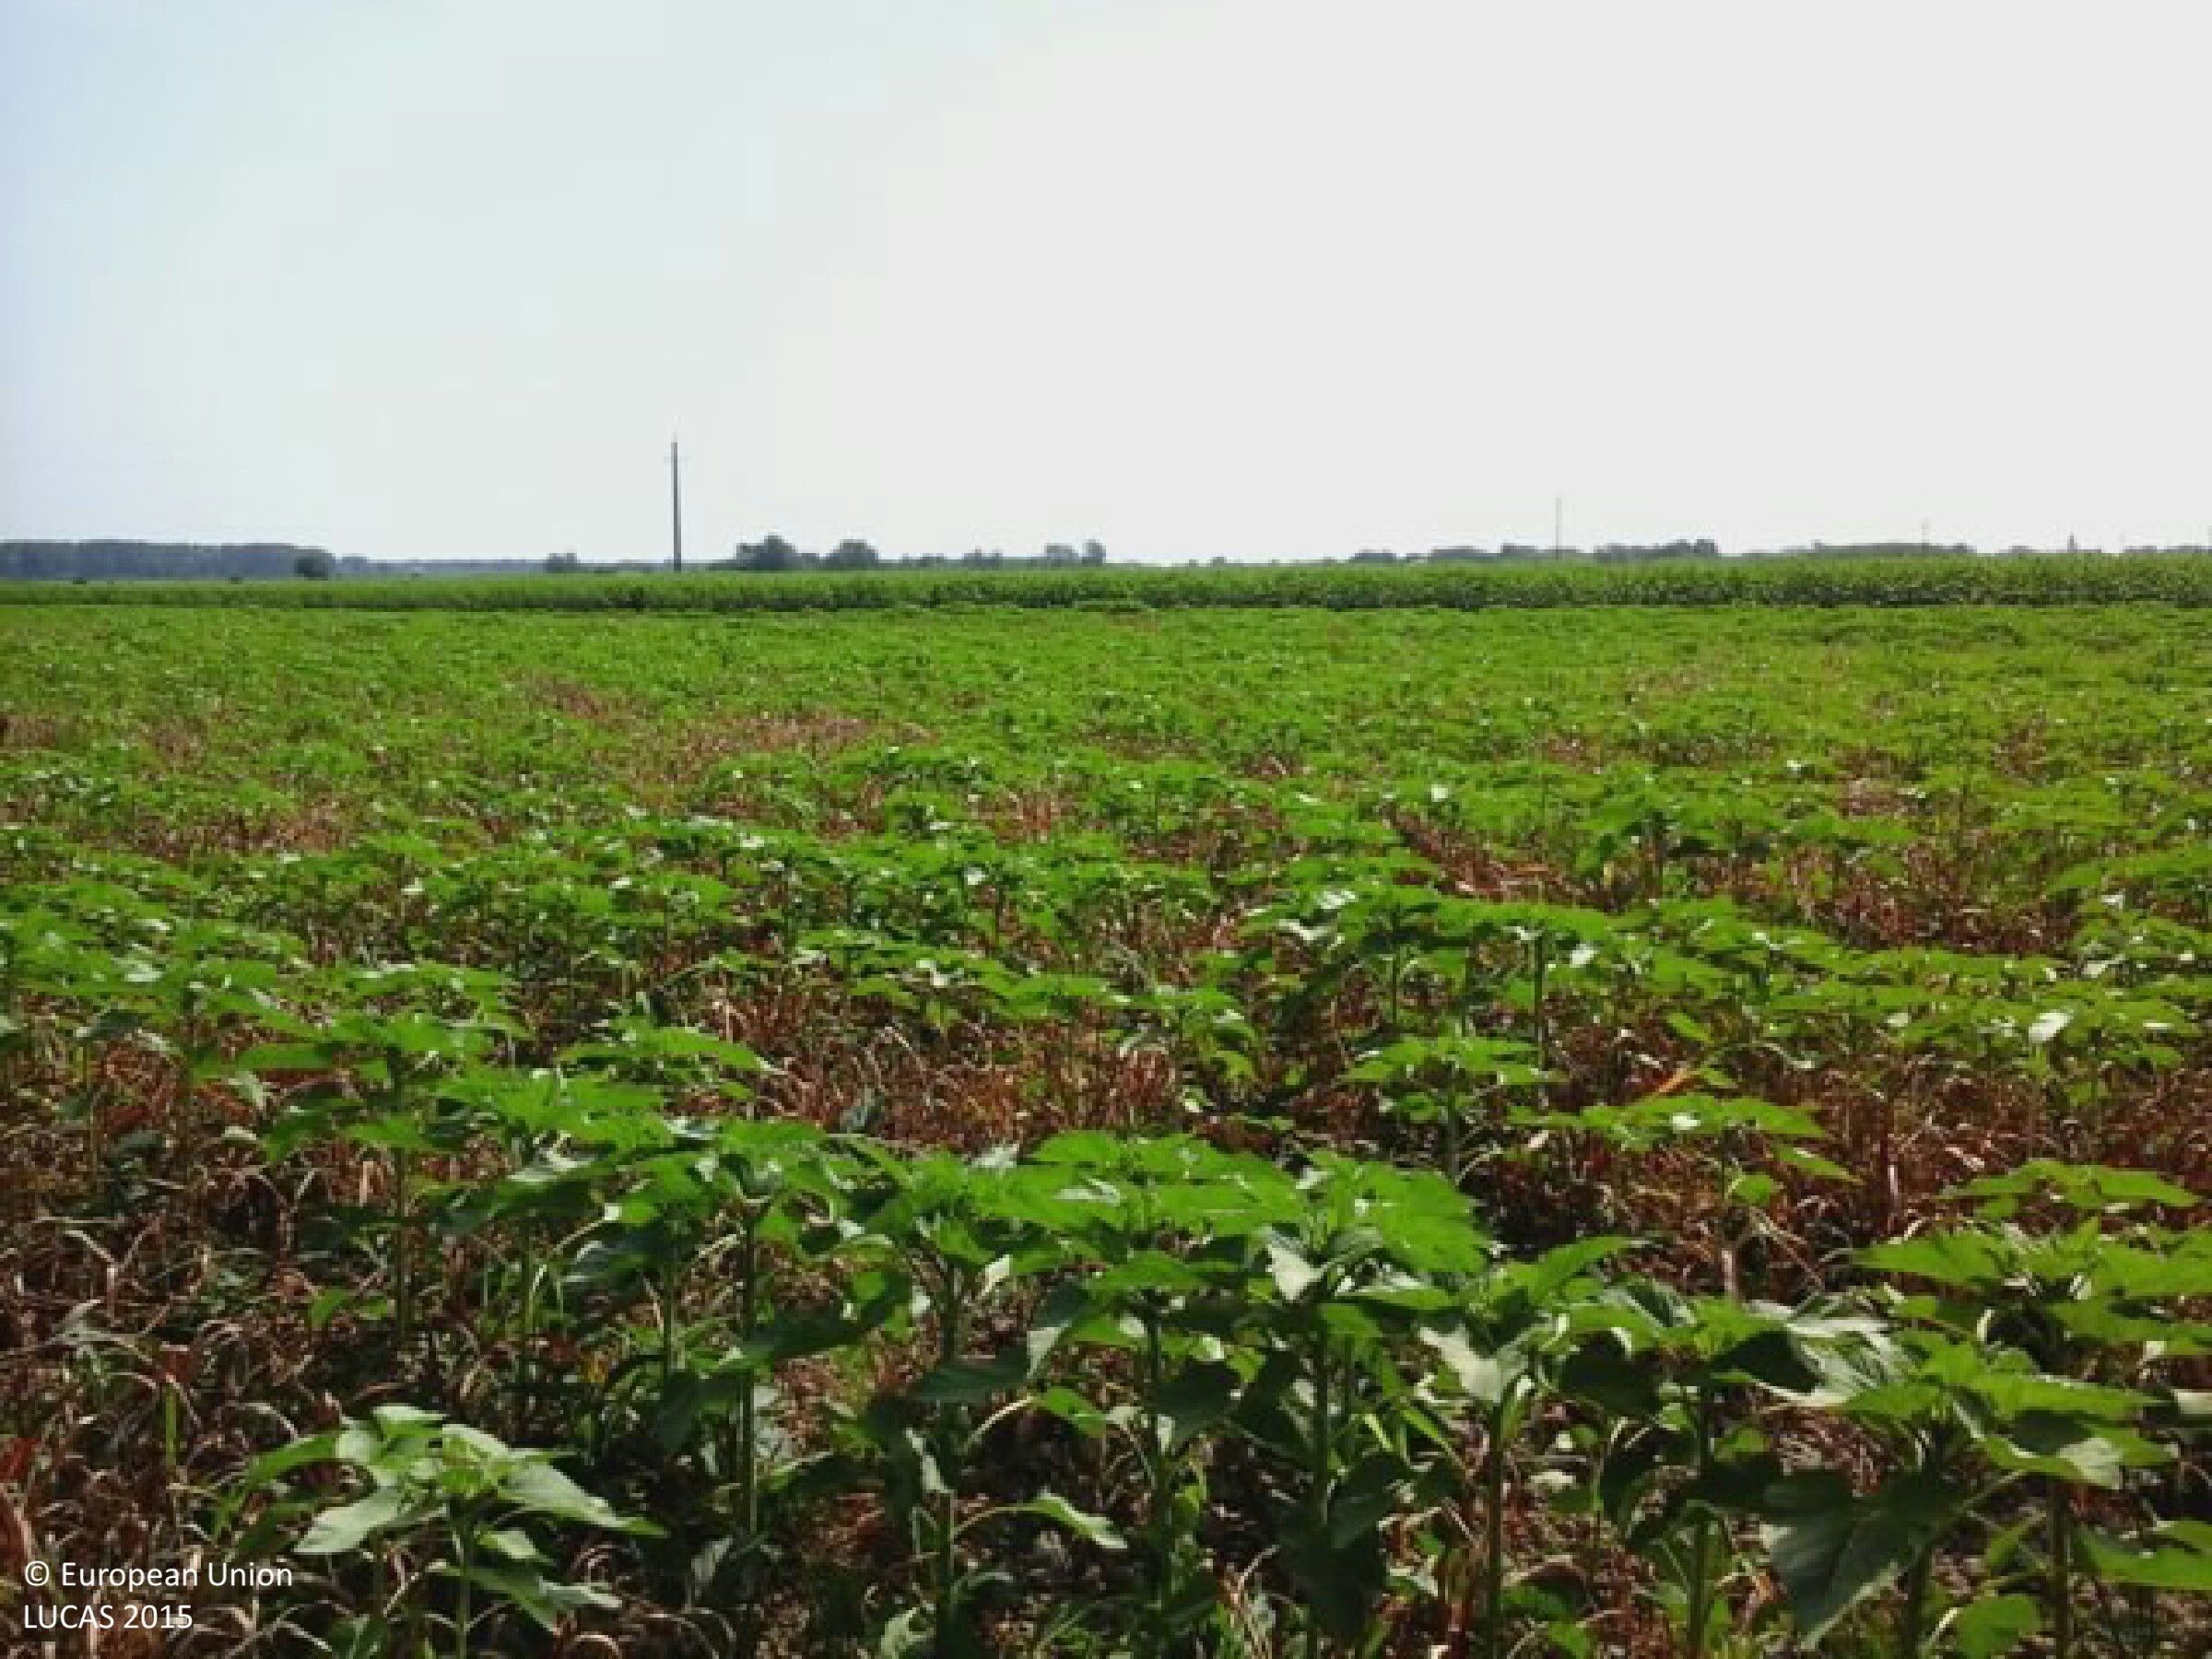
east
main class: Cropland
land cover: Sunflower
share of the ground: 25 - 50 %
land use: Agriculture (excluding fallow land and kitchen gardens)
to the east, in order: Sunflower; Common wheat; Maize
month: June
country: HU
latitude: 46.1065
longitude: 18.8993
